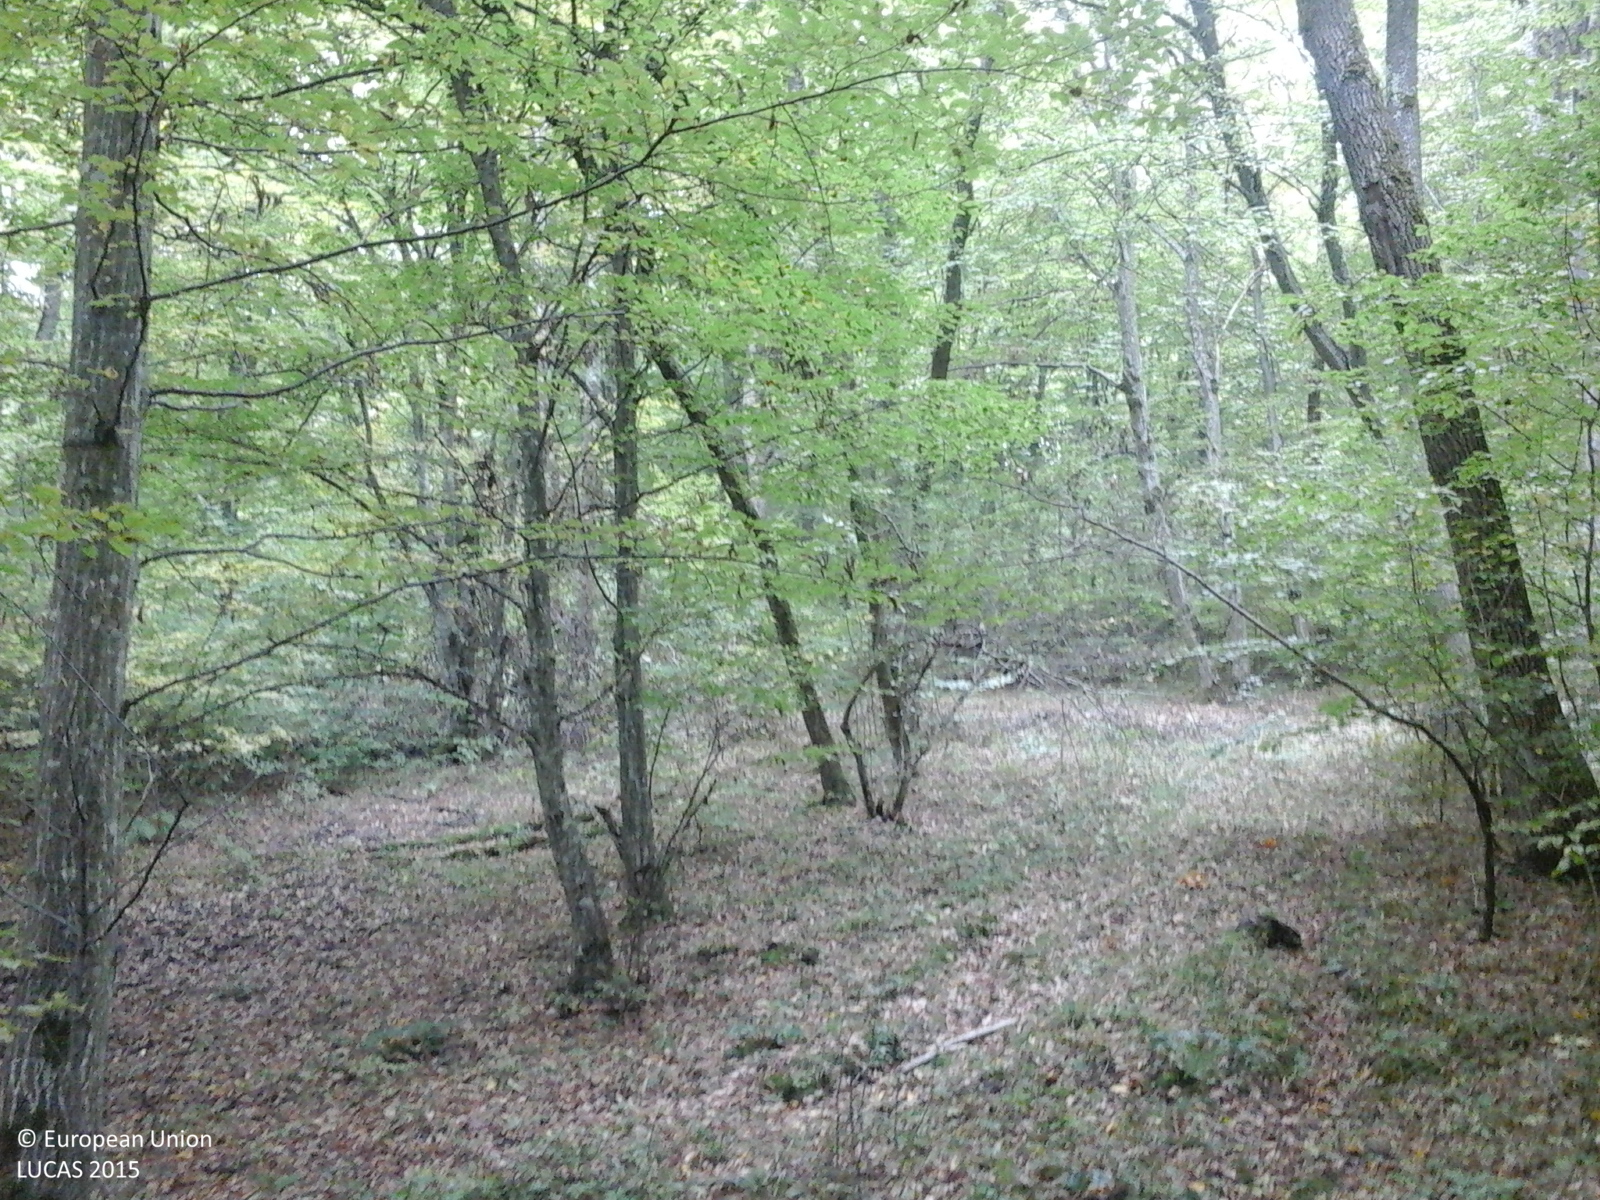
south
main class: Woodland
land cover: Broadleaved woodland
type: beech forest
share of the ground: > 75 %
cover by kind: broadleaved forest trees 100 %
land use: Forestry
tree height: > 5 m
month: October
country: RO
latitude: 46.0429
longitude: 25.3371
